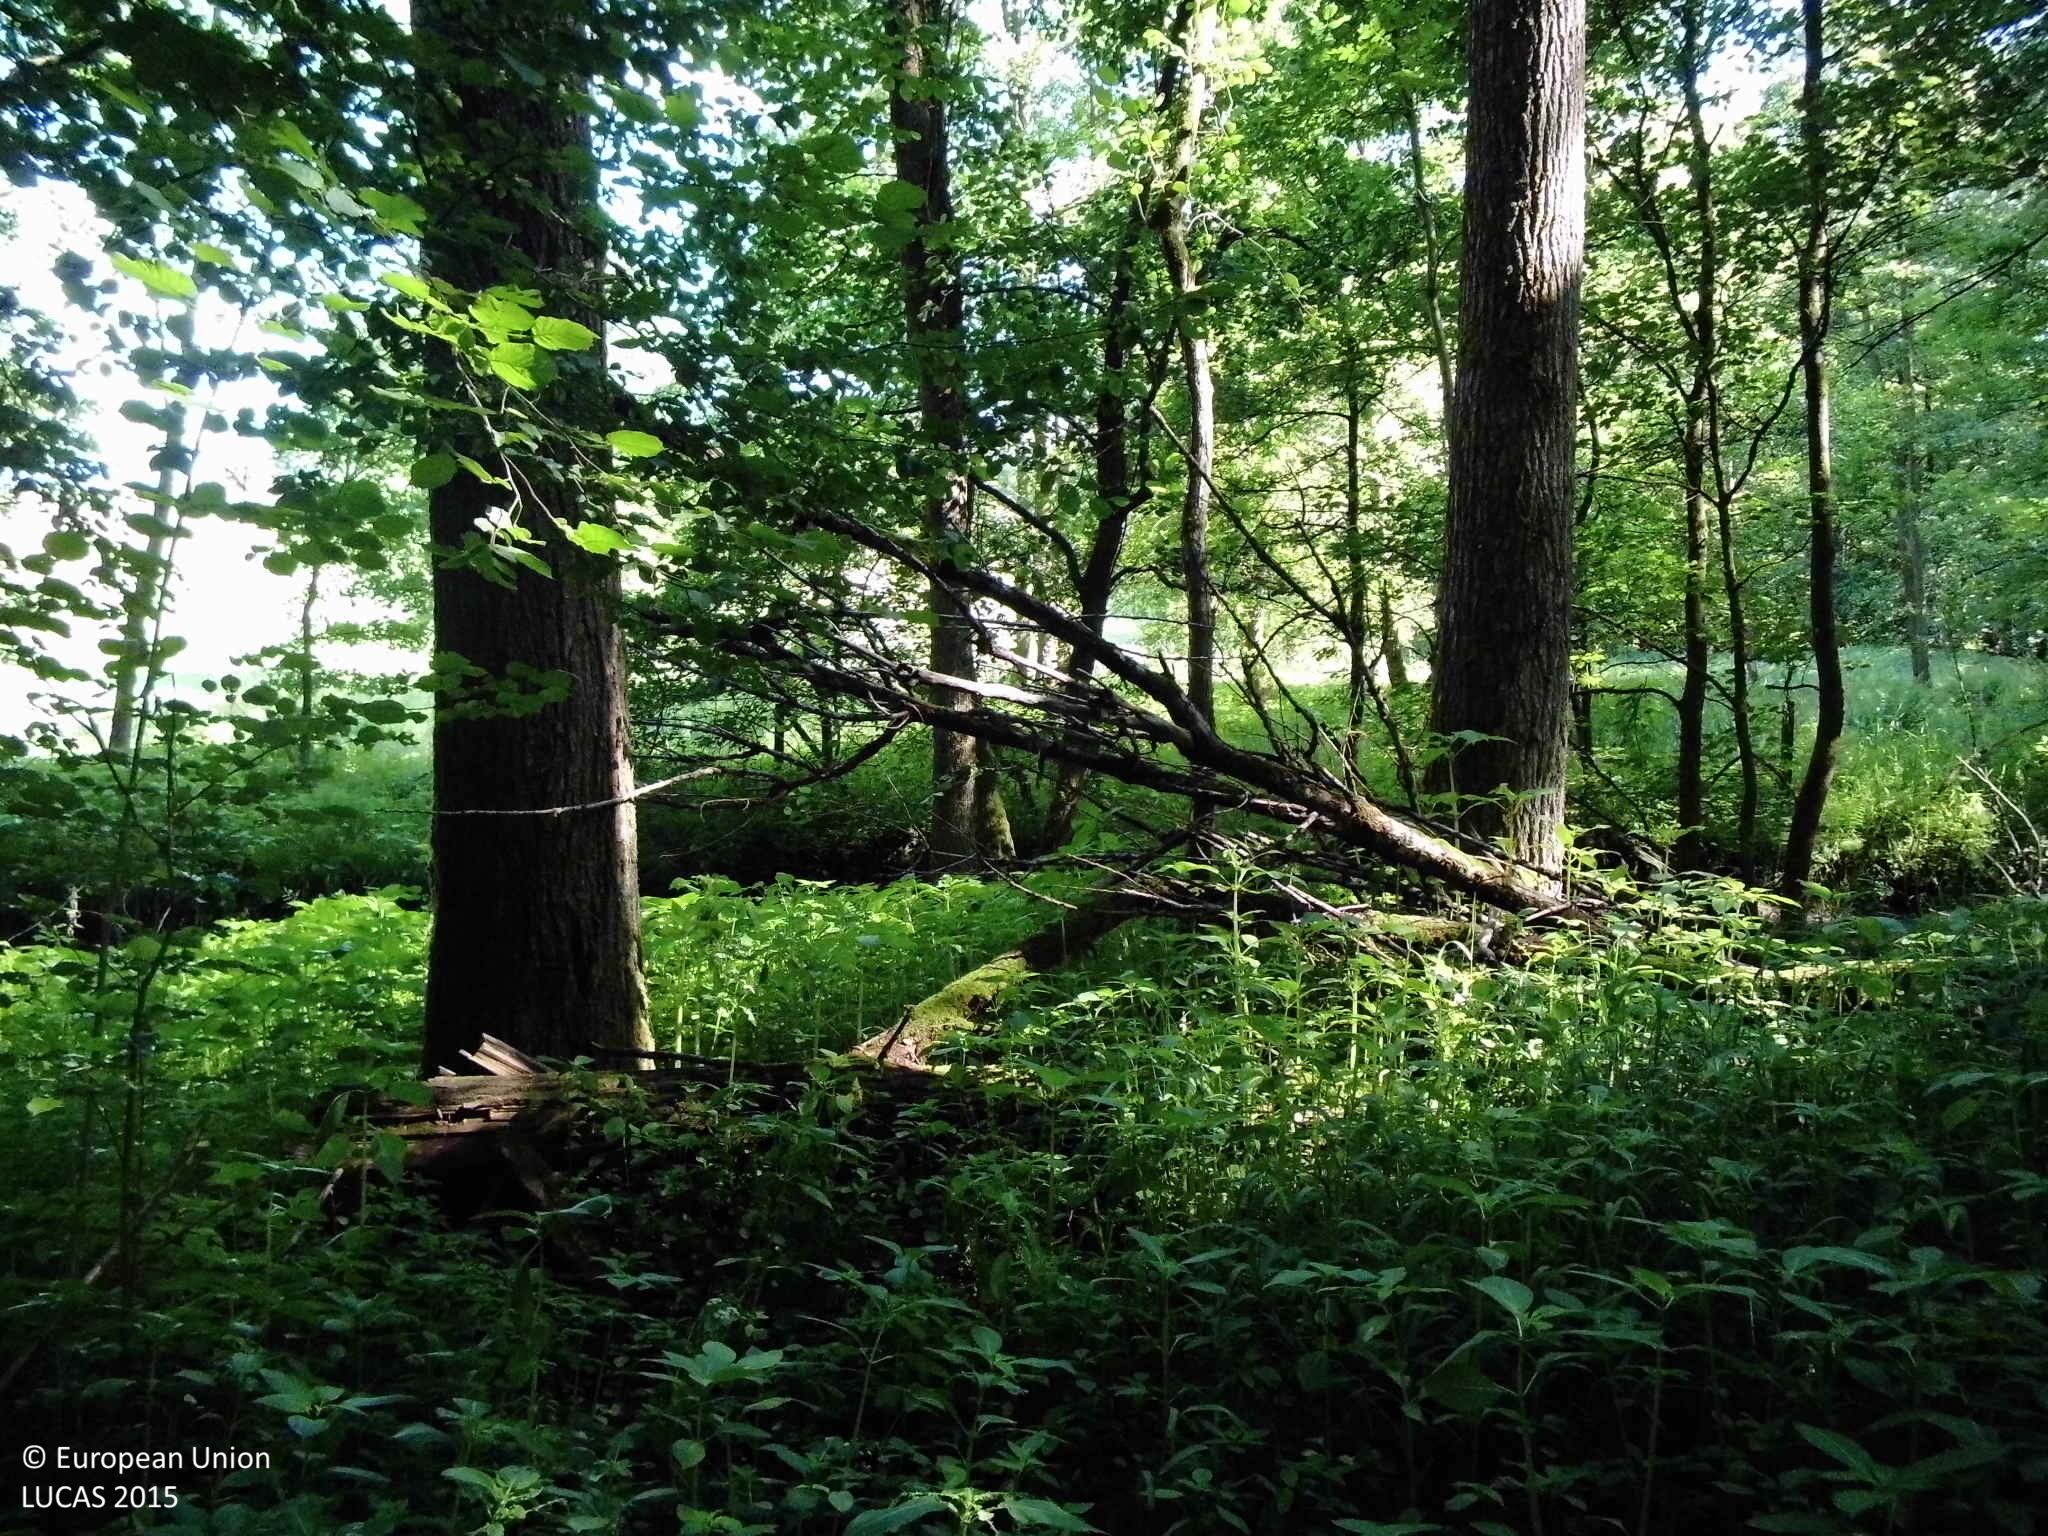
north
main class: Woodland
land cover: Broadleaved woodland
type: mesophytic deciduous forest
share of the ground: > 75 %
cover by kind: broadleaved forest trees 85 %, herbaceous plants 15 %
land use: Forestry
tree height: > 5 m
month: June
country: DE
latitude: 50.9108
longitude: 7.4260
